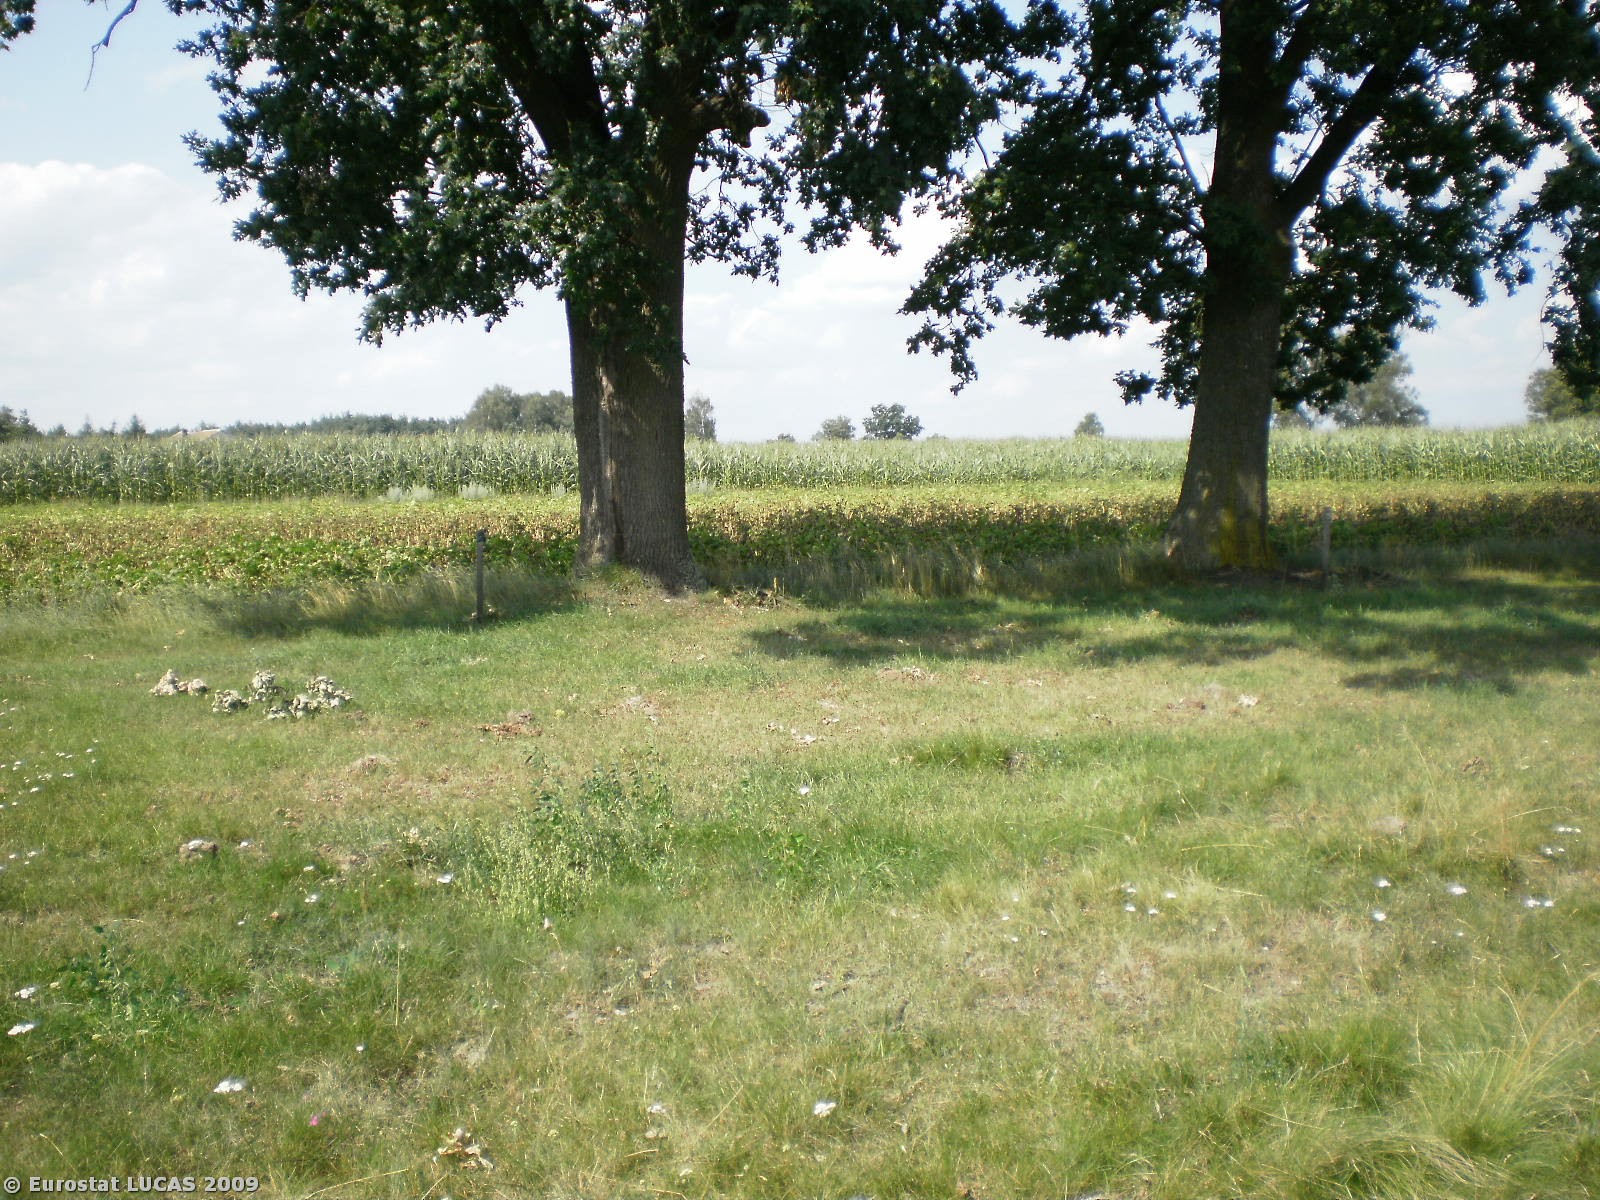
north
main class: Grassland
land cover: Grassland without tree/shrub cover
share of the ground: > 75 %
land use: Agriculture (excluding fallow land and kitchen gardens)
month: July
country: PL
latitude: 53.2824
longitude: 20.9774
